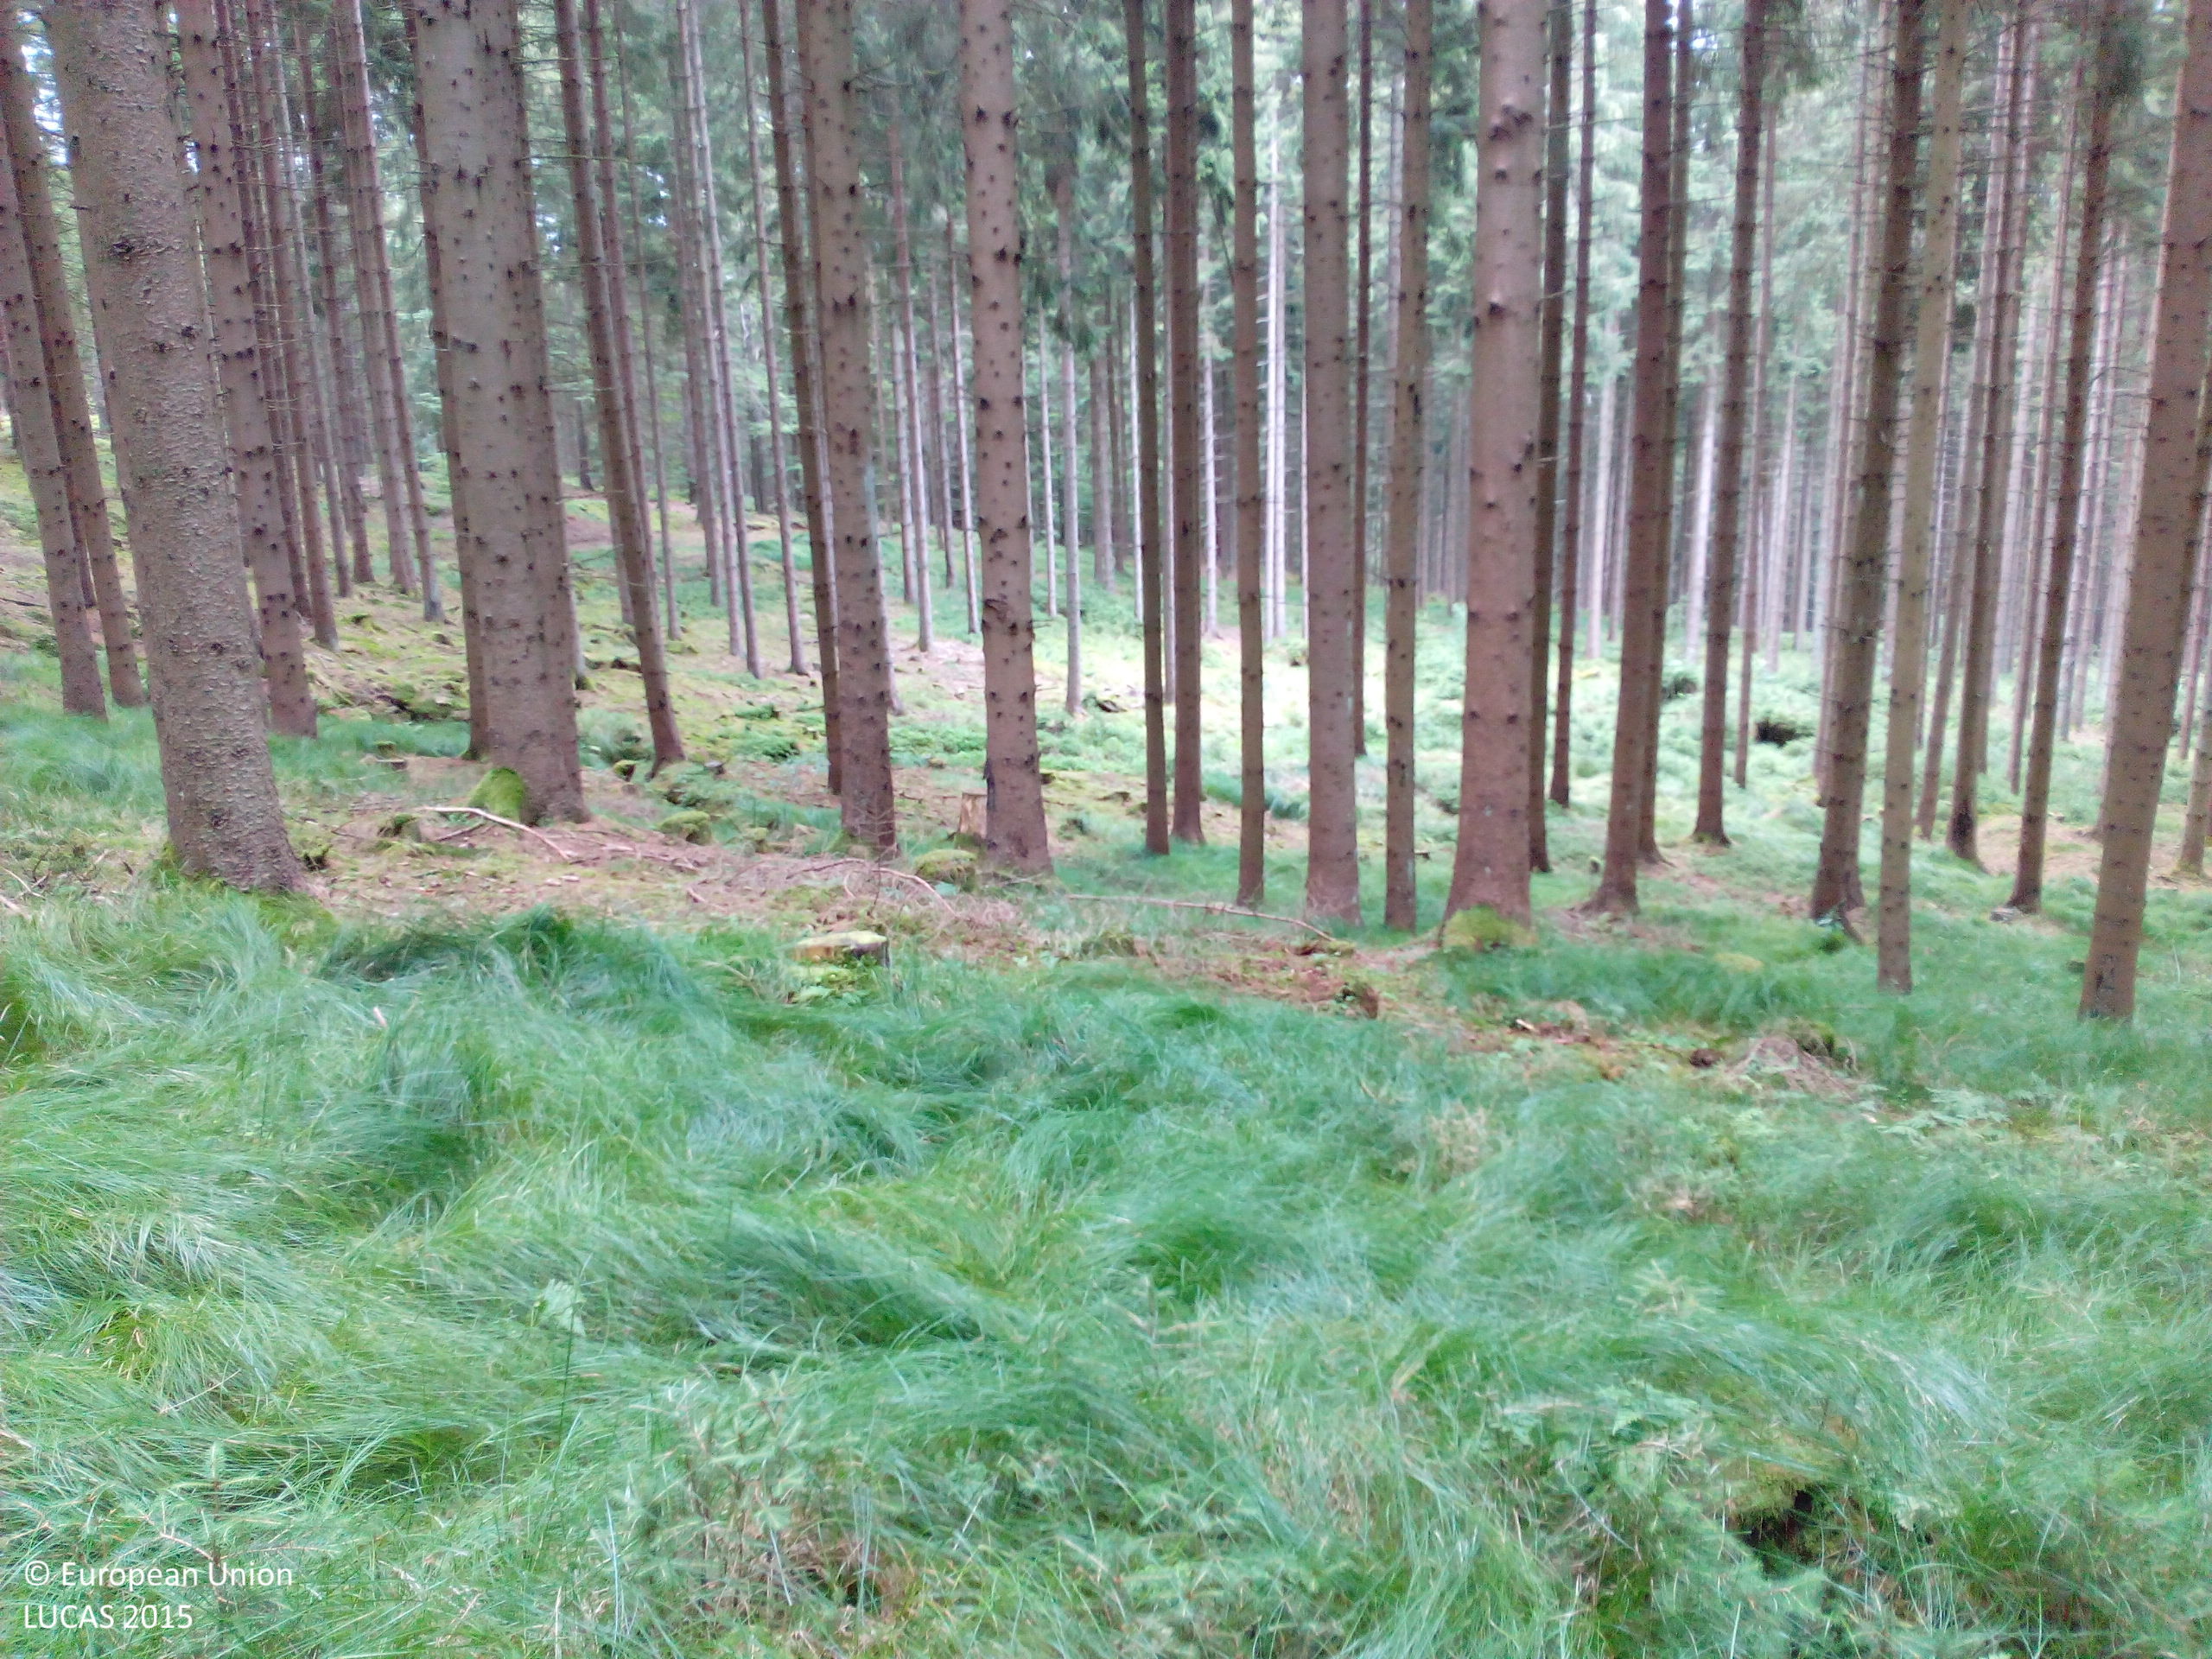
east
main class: Woodland
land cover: Spruce dominated coniferous woodland
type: hemiboreal forest and nemoral coniferous forest and mixed broadleaved-coniferous forest
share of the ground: 50 - 75 %
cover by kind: coniferous forest trees 70 %, herbaceous plants 30 %
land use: Forestry
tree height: > 5 m
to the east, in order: Spruce dominated coniferous woodland; Rivers and streams; Spruce dominated coniferous woodland; Rivers and streams; Spruce dominated coniferous woodland; Tracks; Spruce dominated coniferous woodland; Tracks; Spruce dominated coniferous woodland
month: July
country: DE
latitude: 49.1017
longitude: 12.9718
